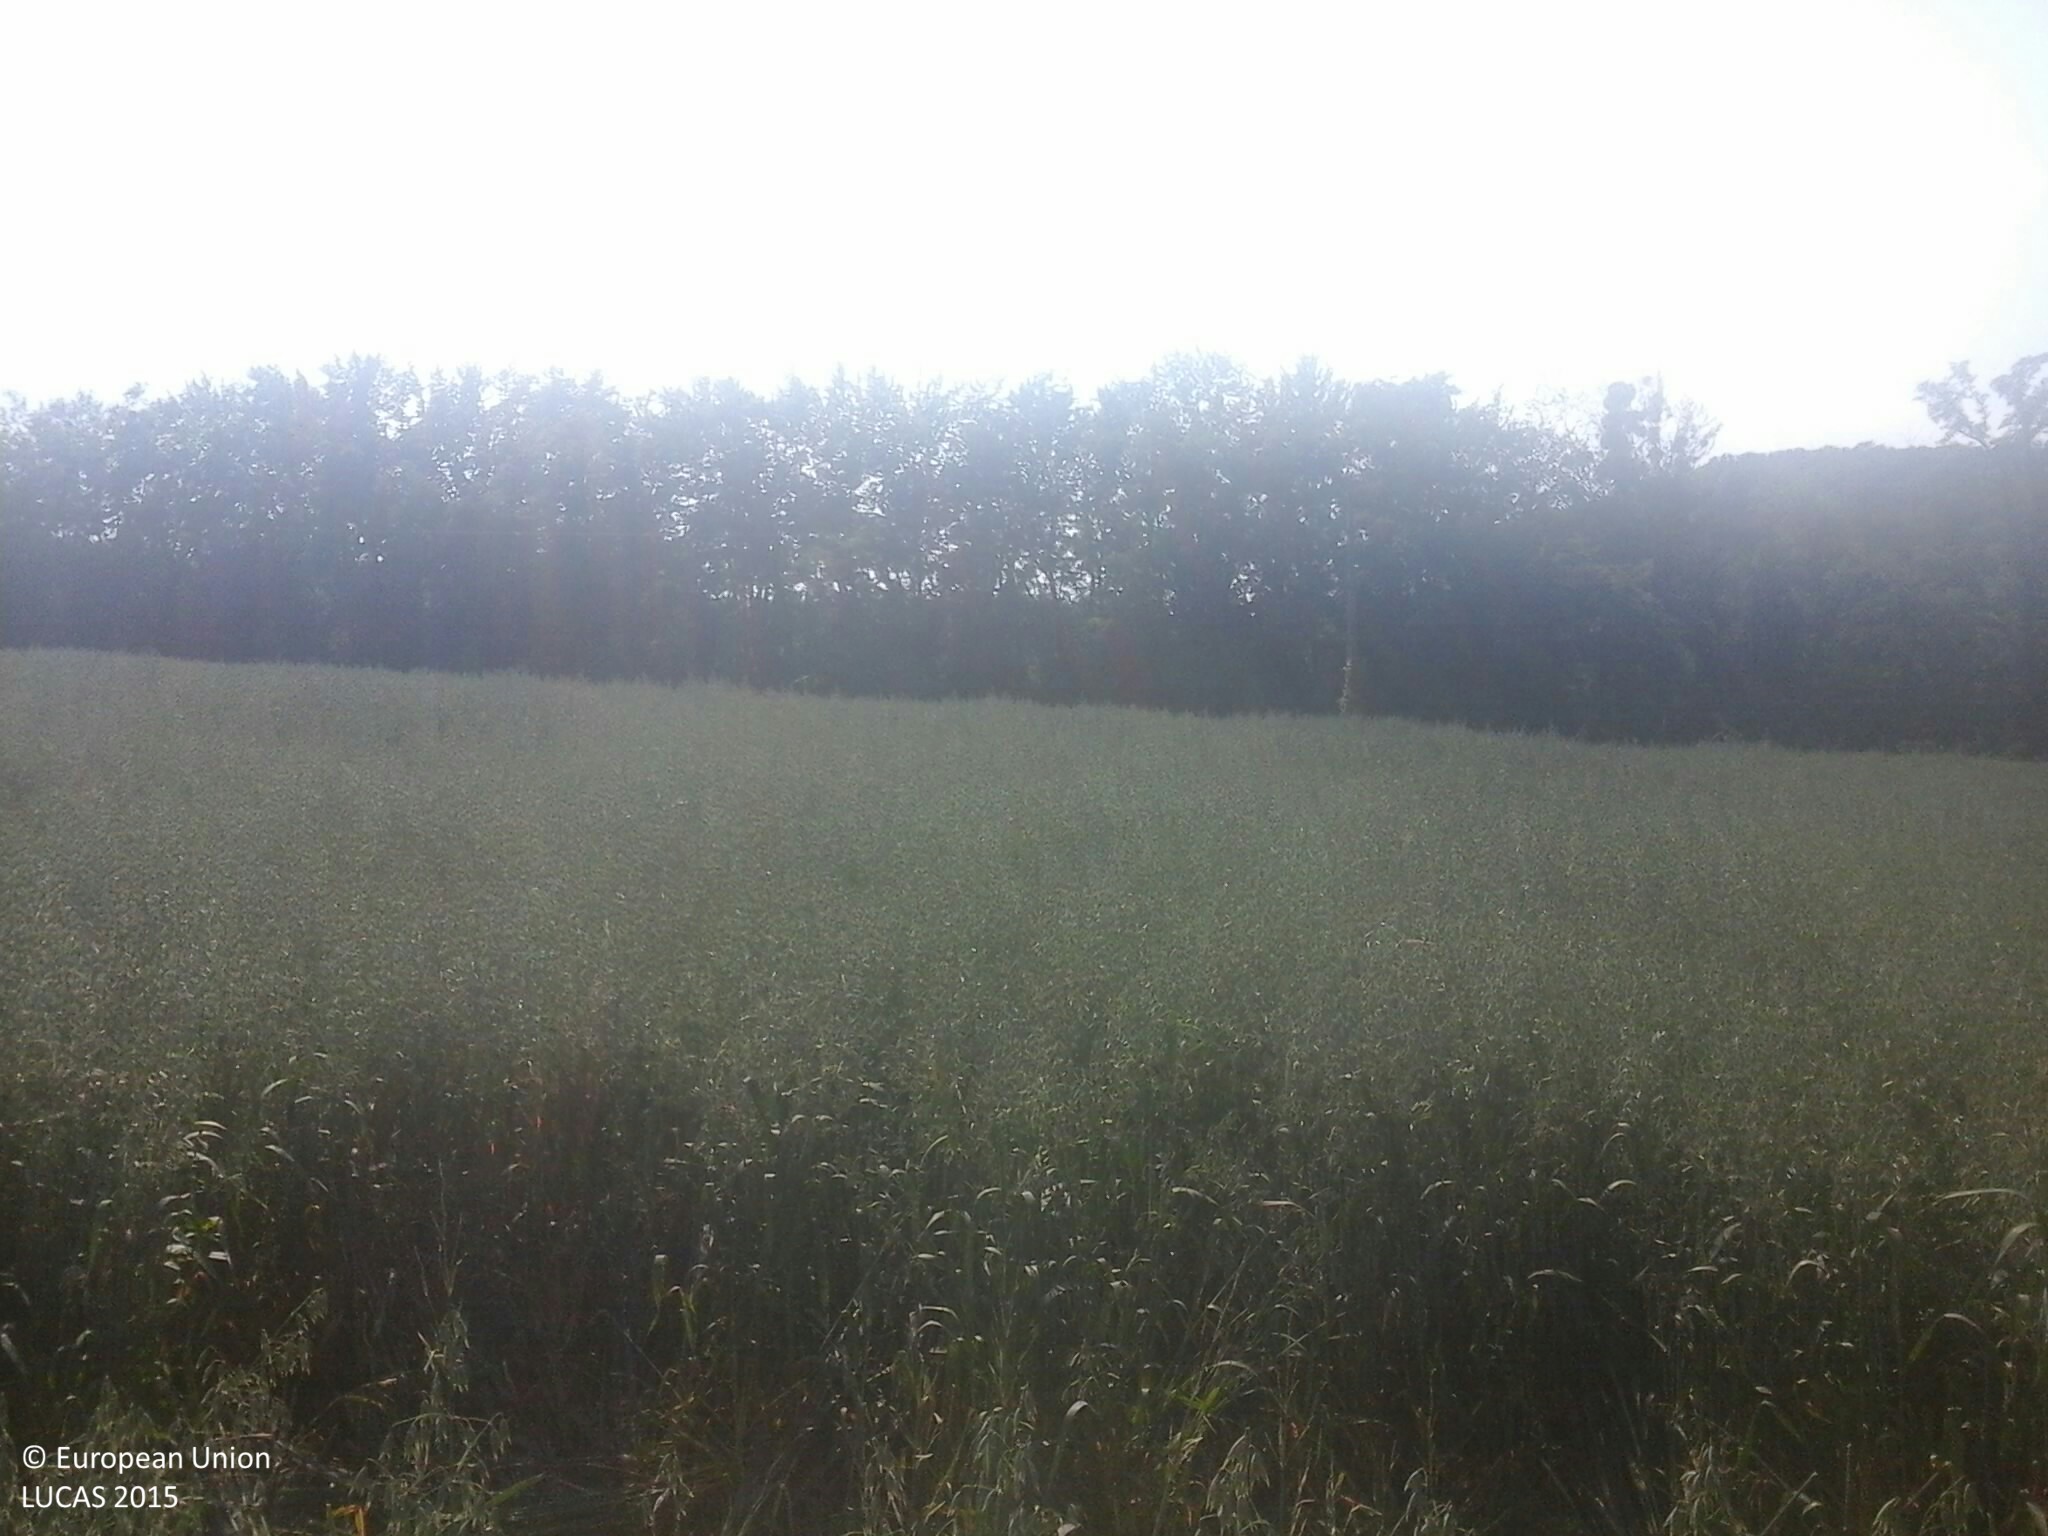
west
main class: Cropland
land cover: Oats
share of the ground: > 75 %
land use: Agriculture (excluding fallow land and kitchen gardens)
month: July
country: HU
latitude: 47.2905
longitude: 17.8770
